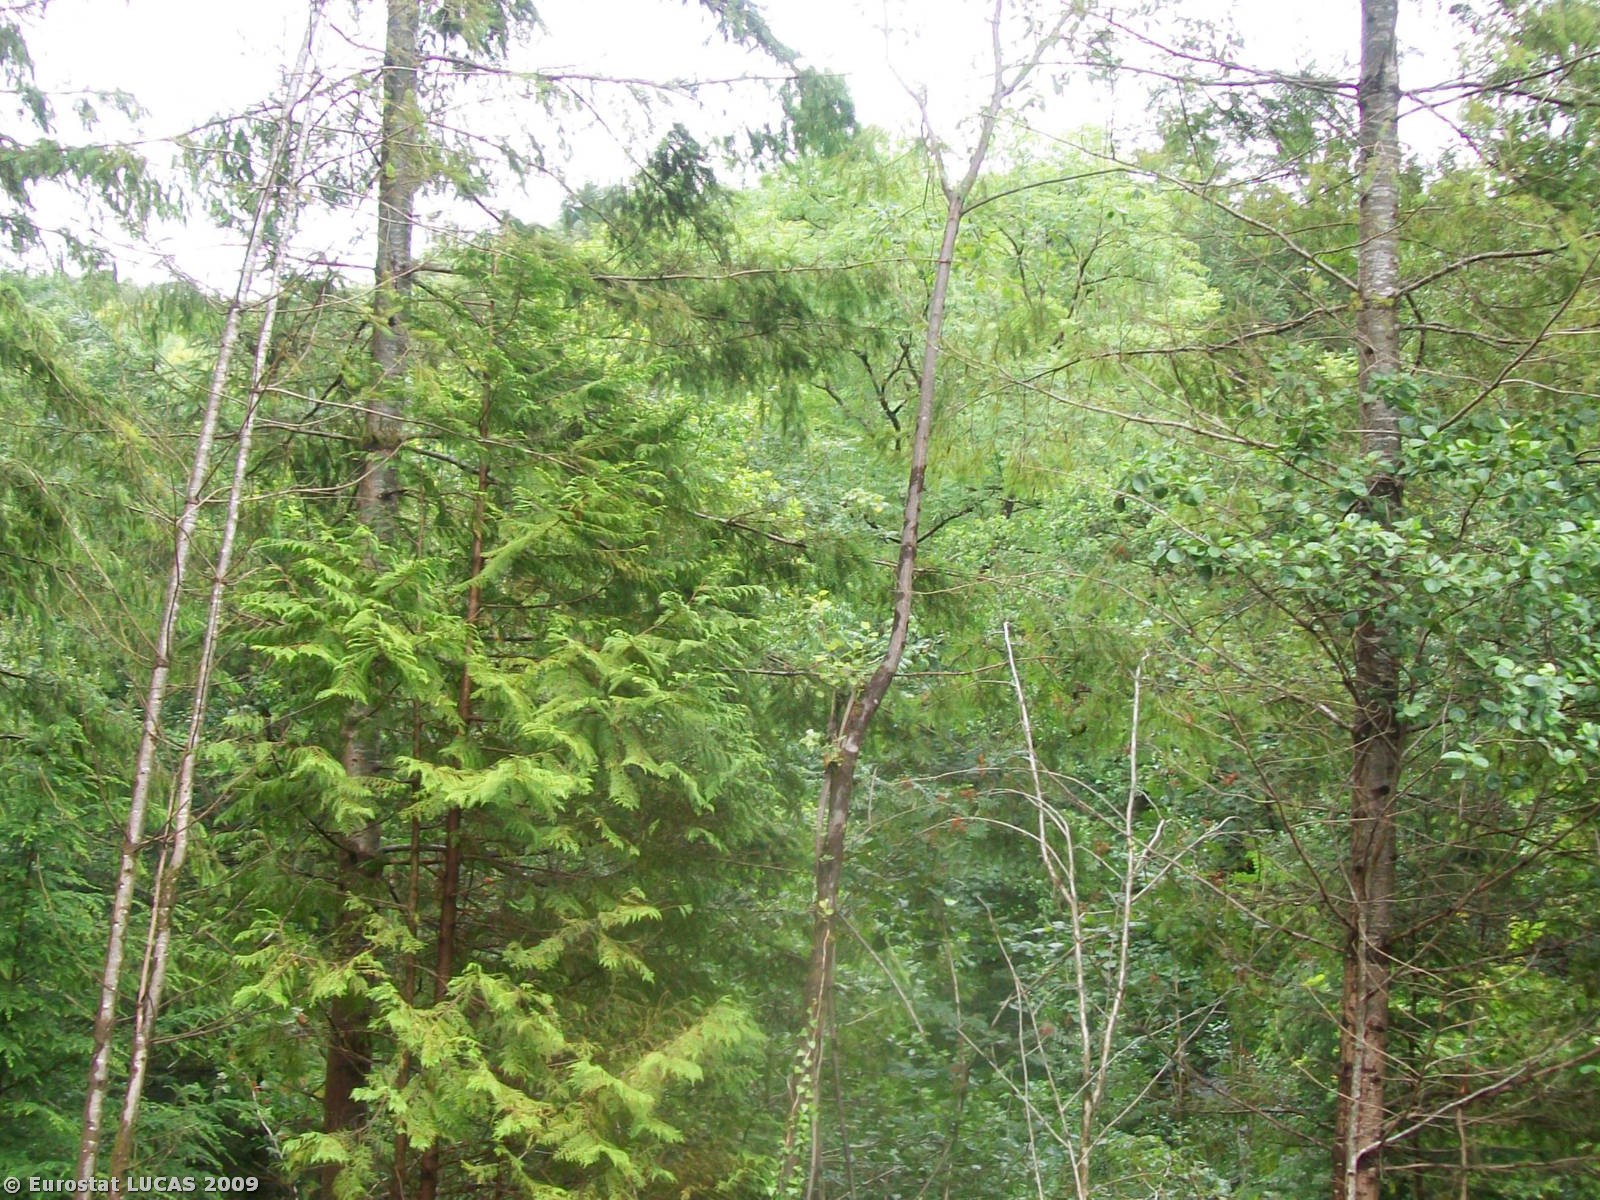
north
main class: Woodland
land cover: Coniferous woodland
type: plantations and self-sown exotic forest
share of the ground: > 75 %
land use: Forestry
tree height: > 5 m
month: July
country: GB
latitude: 52.6341
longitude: -3.8778
